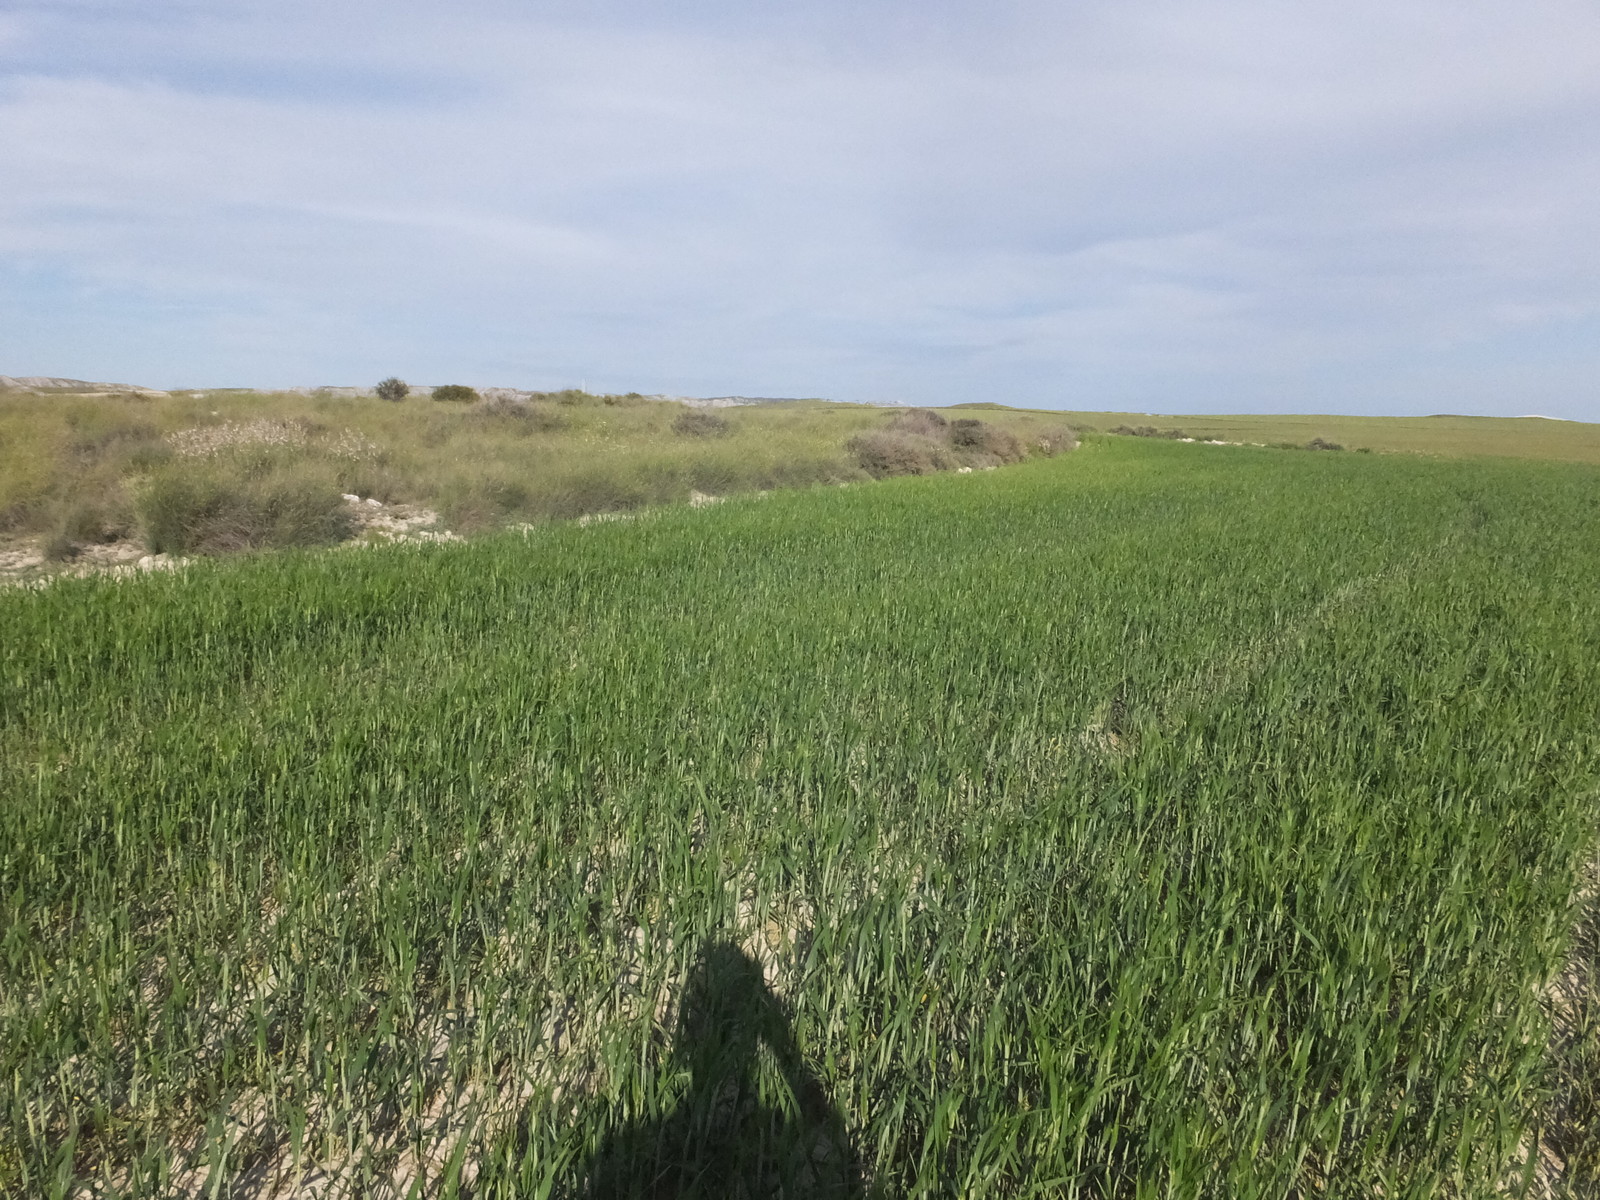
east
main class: Cropland
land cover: Common wheat
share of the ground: > 75 %
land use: Agriculture (excluding fallow land and kitchen gardens)
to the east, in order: Common wheat; Shrubland without tree cover; Barley
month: April
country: ES
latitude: 41.5617
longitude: -0.3172
